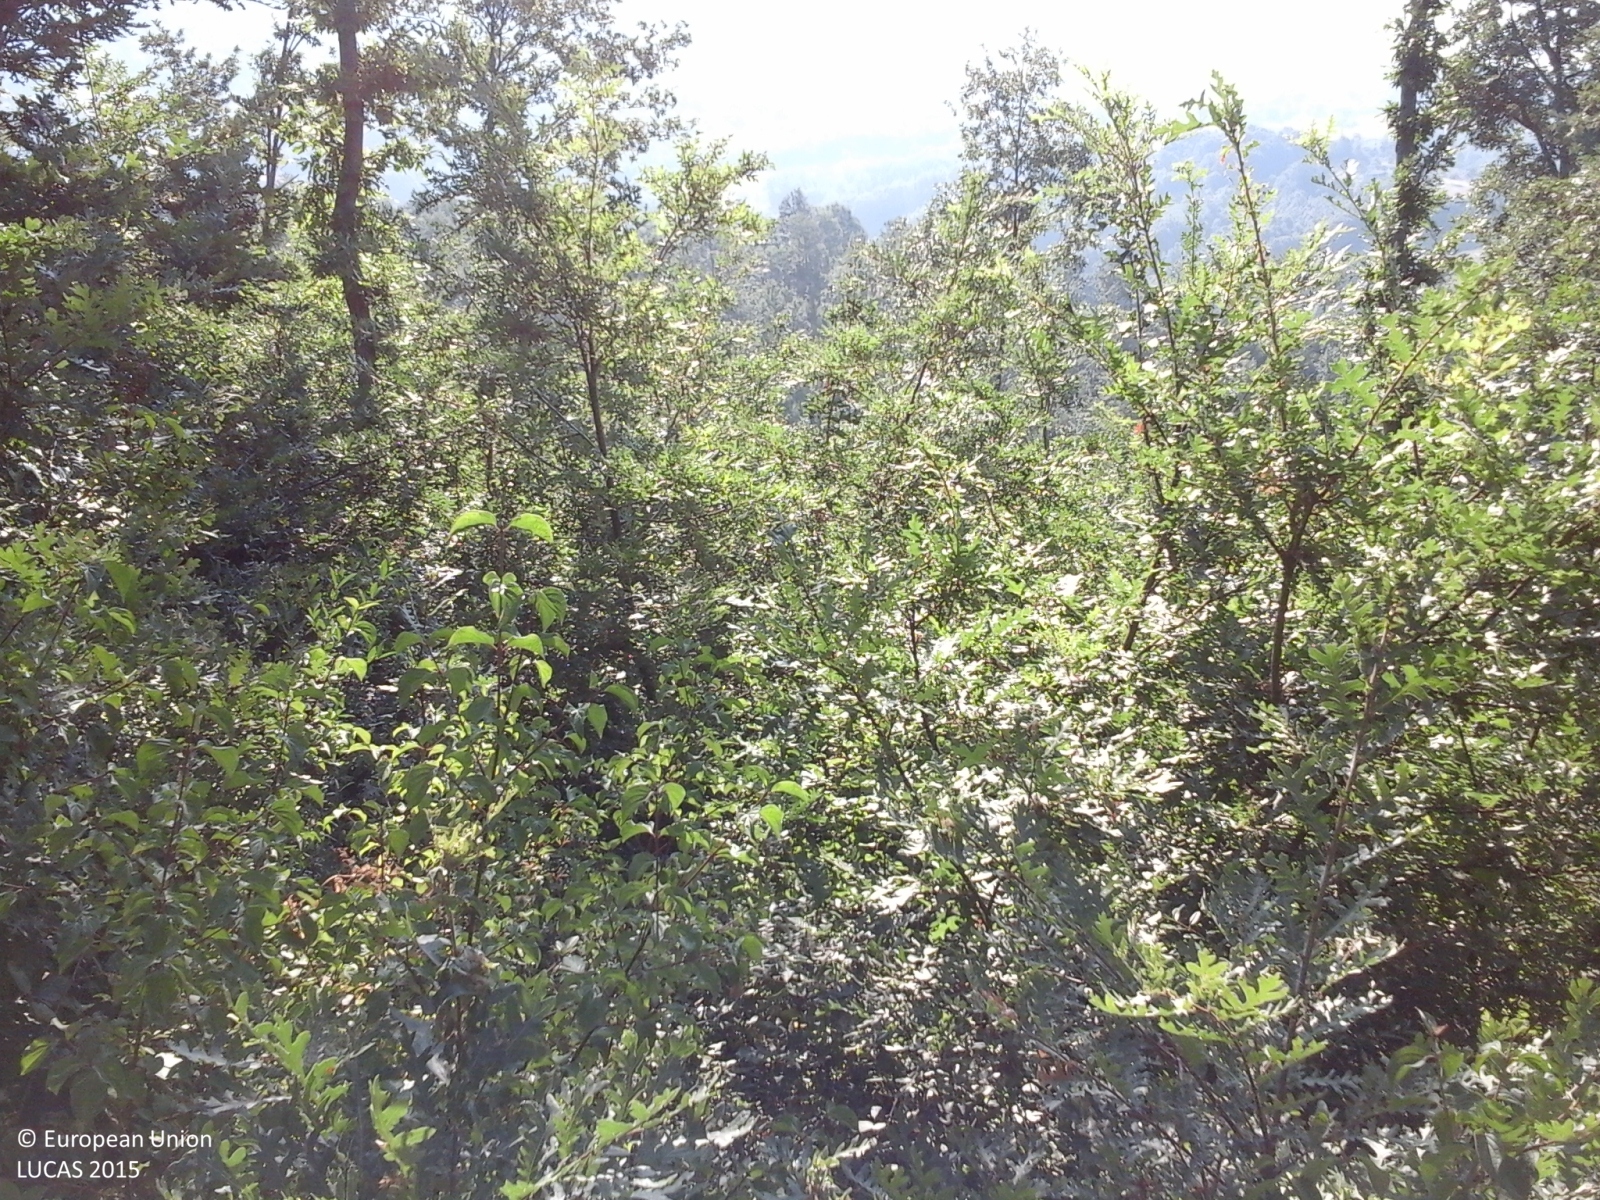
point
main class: Woodland
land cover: Broadleaved woodland
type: thermophilous deciduous forest
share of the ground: > 75 %
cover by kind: broadleaved forest trees 90 %, shrubs 5 %, herbaceous plants 5 %
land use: Forestry
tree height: > 5 m
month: July
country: IT
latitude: 41.4597
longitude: 14.6883
